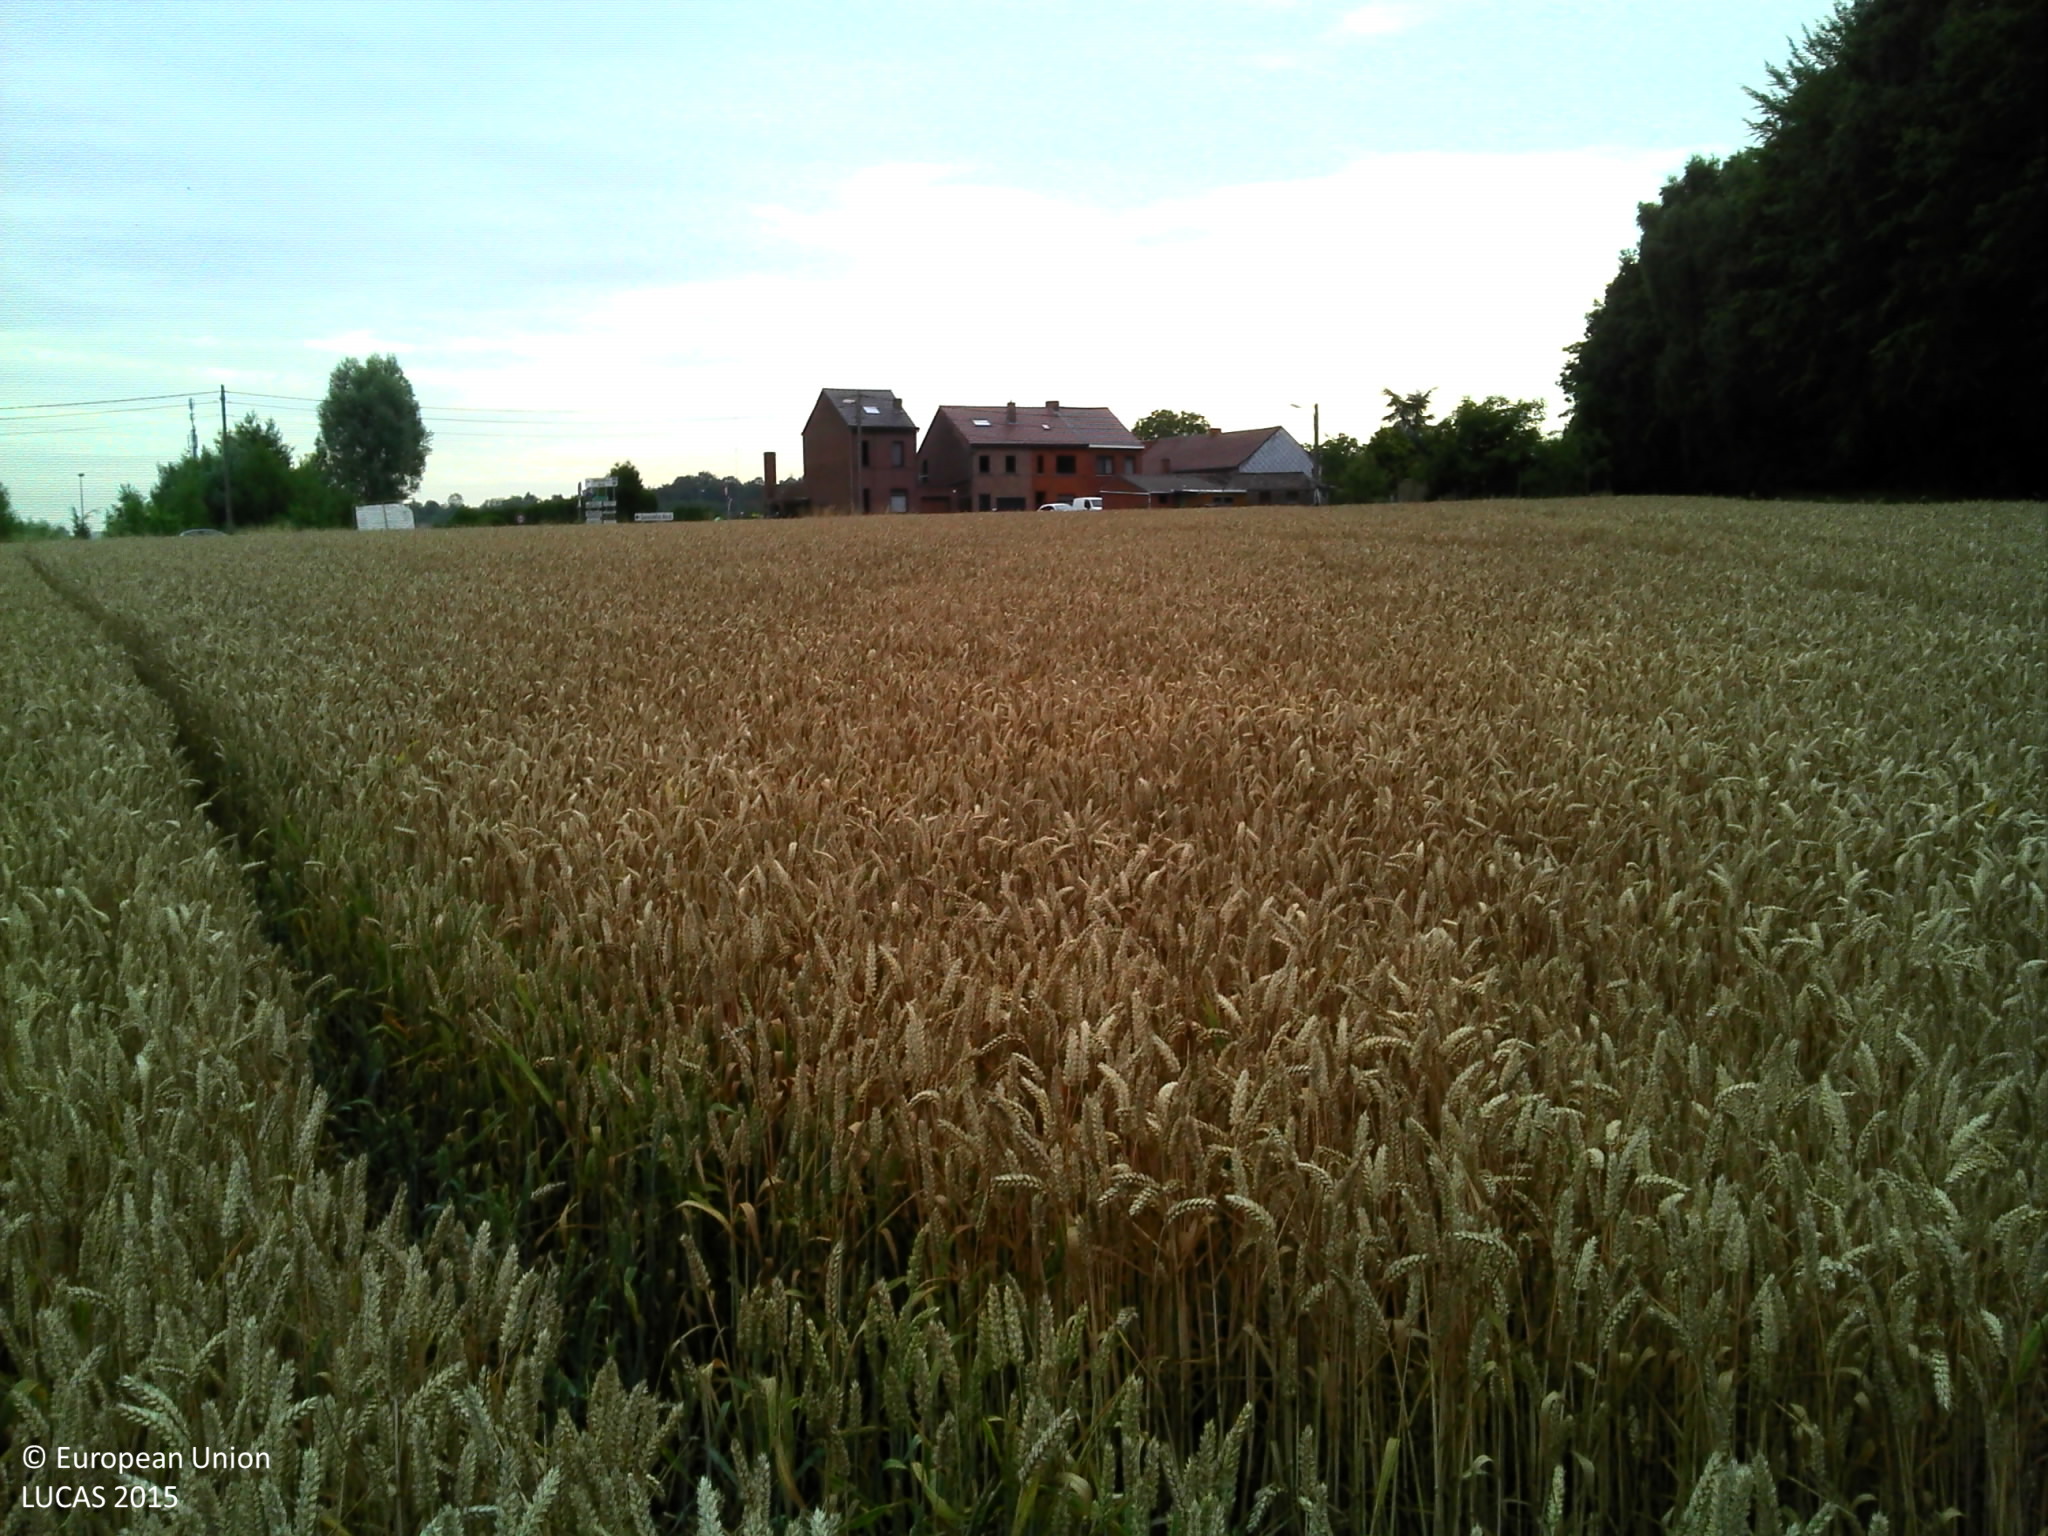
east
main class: Cropland
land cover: Common wheat
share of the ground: > 75 %
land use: Agriculture (excluding fallow land and kitchen gardens)
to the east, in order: Common wheat; Artificial constructions in urban areas; Grassland without tree/shrub cover; Managed hedges
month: July
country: BE
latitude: 50.5039
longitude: 4.1717
